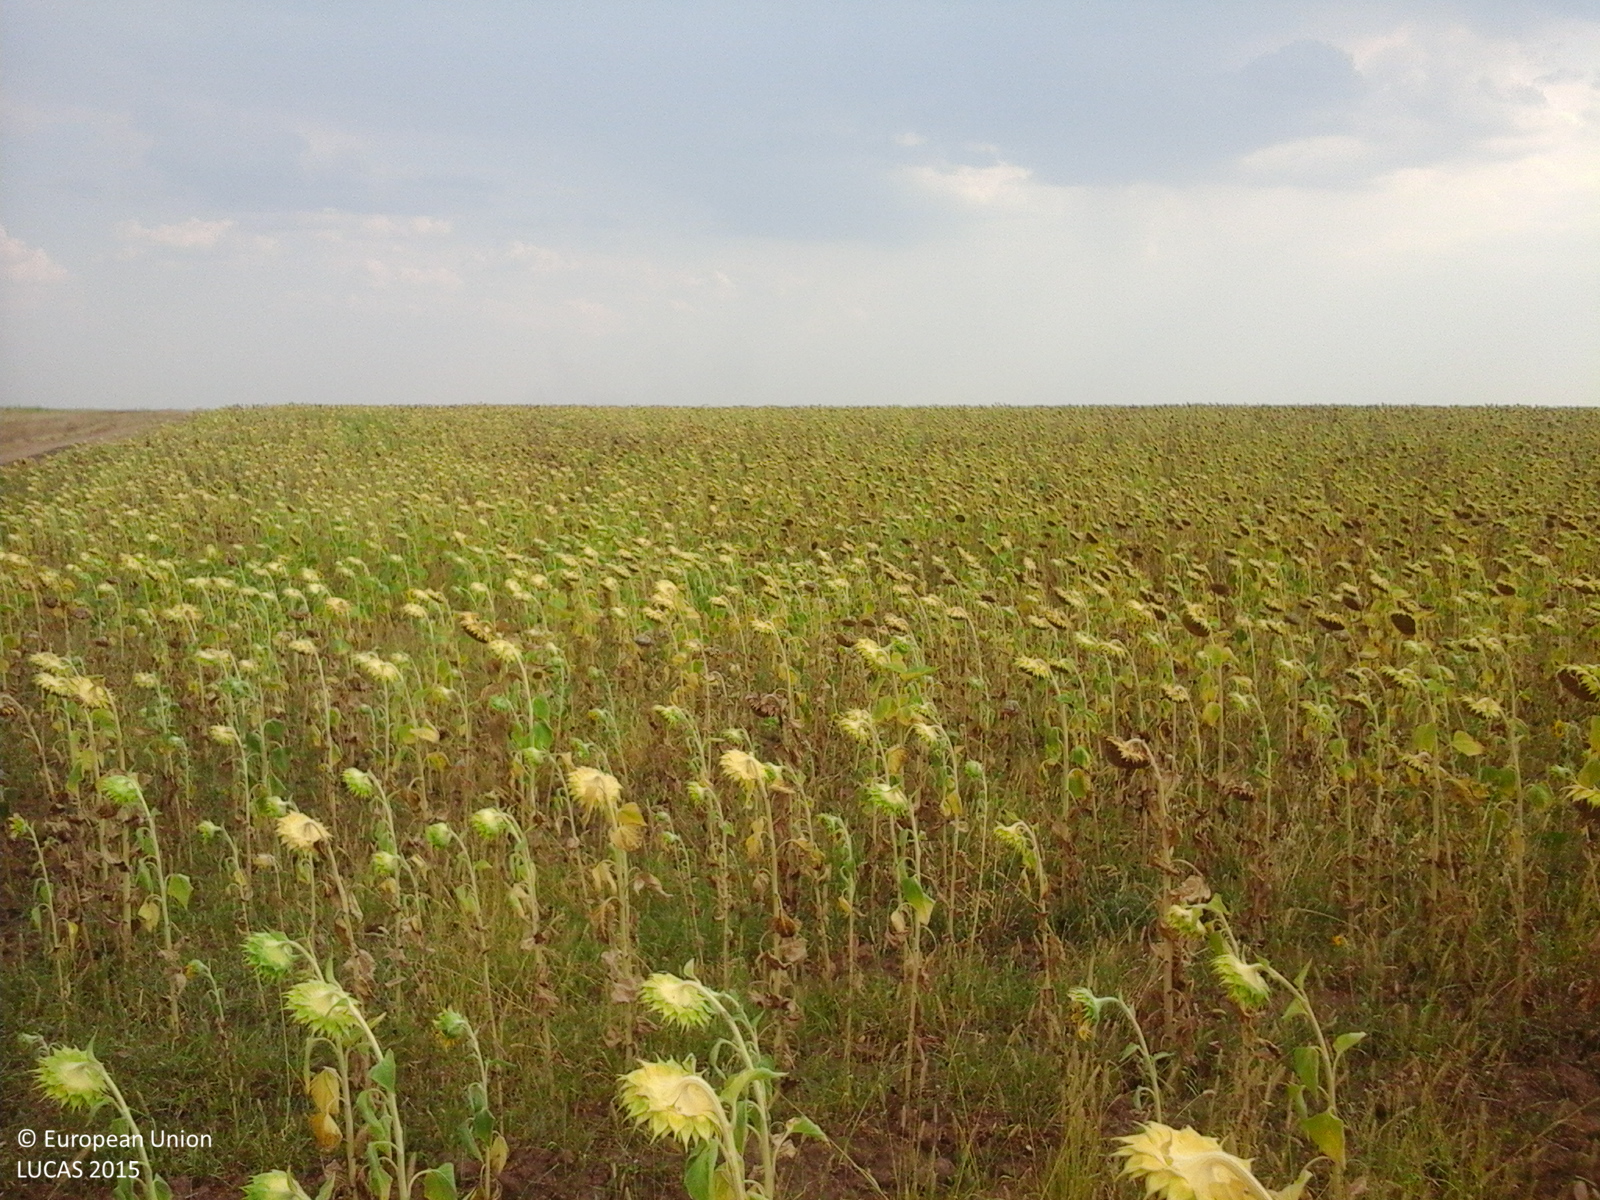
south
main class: Cropland
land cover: Sunflower
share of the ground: > 75 %
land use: Agriculture (excluding fallow land and kitchen gardens)
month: August
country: RO
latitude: 44.3517
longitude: 23.1309
